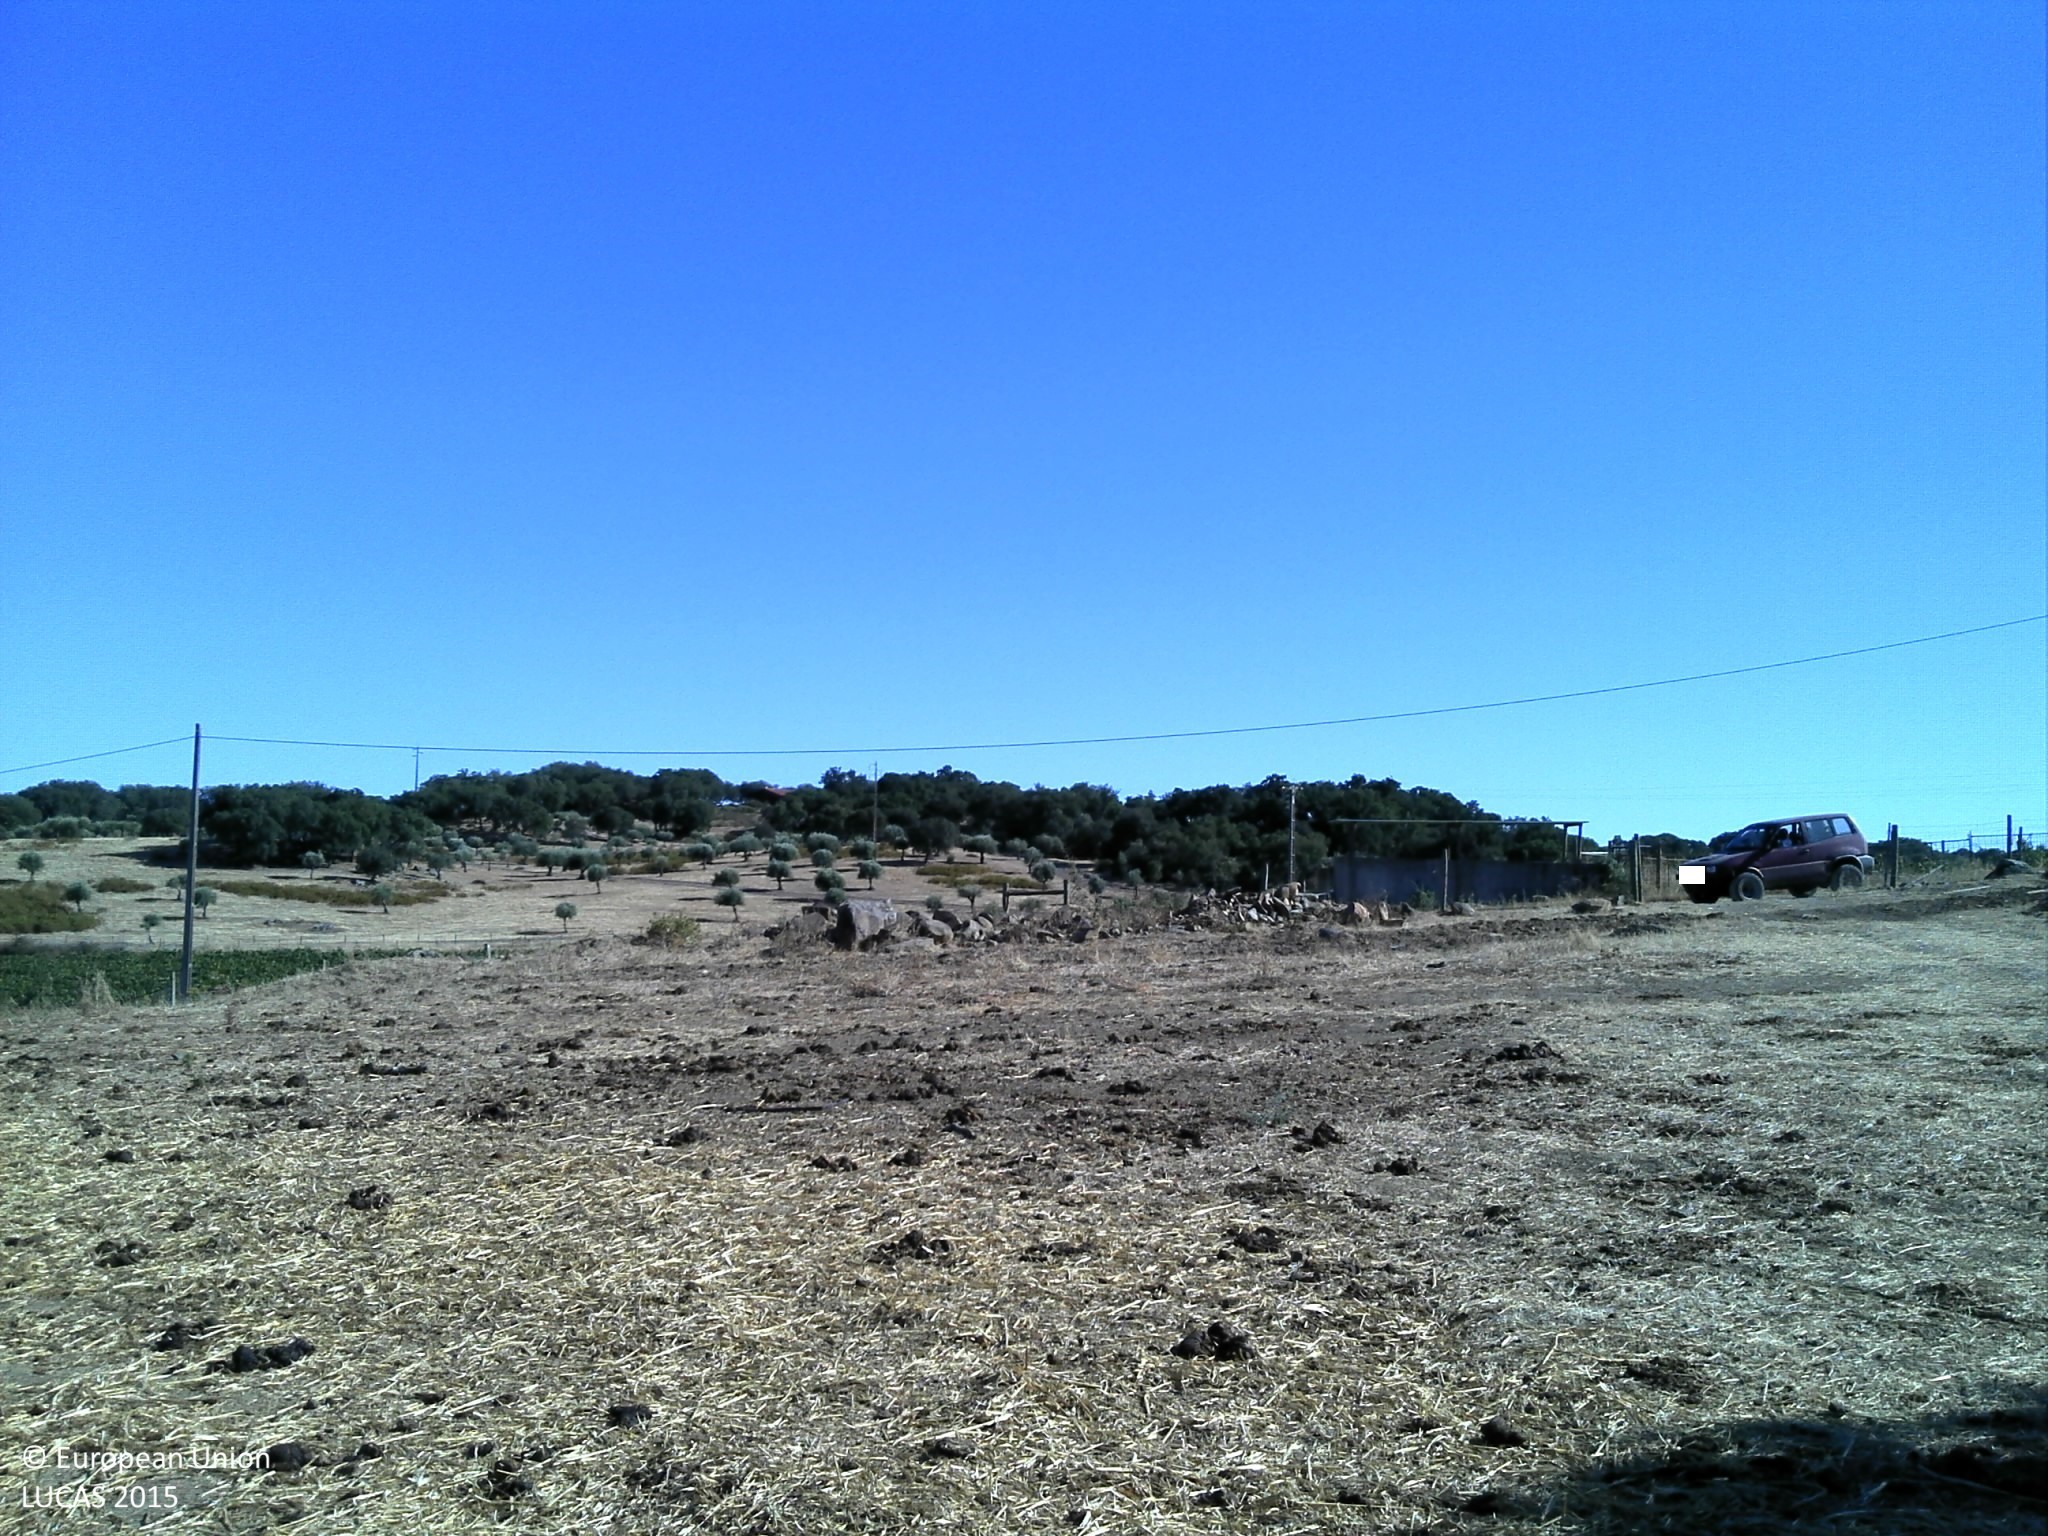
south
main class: Woodland
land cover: Broadleaved woodland
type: broadleaved evergreen forest
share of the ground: 10 - 25 %
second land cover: Grassland without tree/shrub cover
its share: 10 - 25 %
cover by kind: unconsolidated bare surface 75 %, herbaceous plants 15 %, broadleaved forest trees 10 %
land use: Forestry
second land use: Agriculture (excluding fallow land and kitchen gardens)
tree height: > 5 m
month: August
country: PT
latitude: 39.5198
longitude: -7.5550
